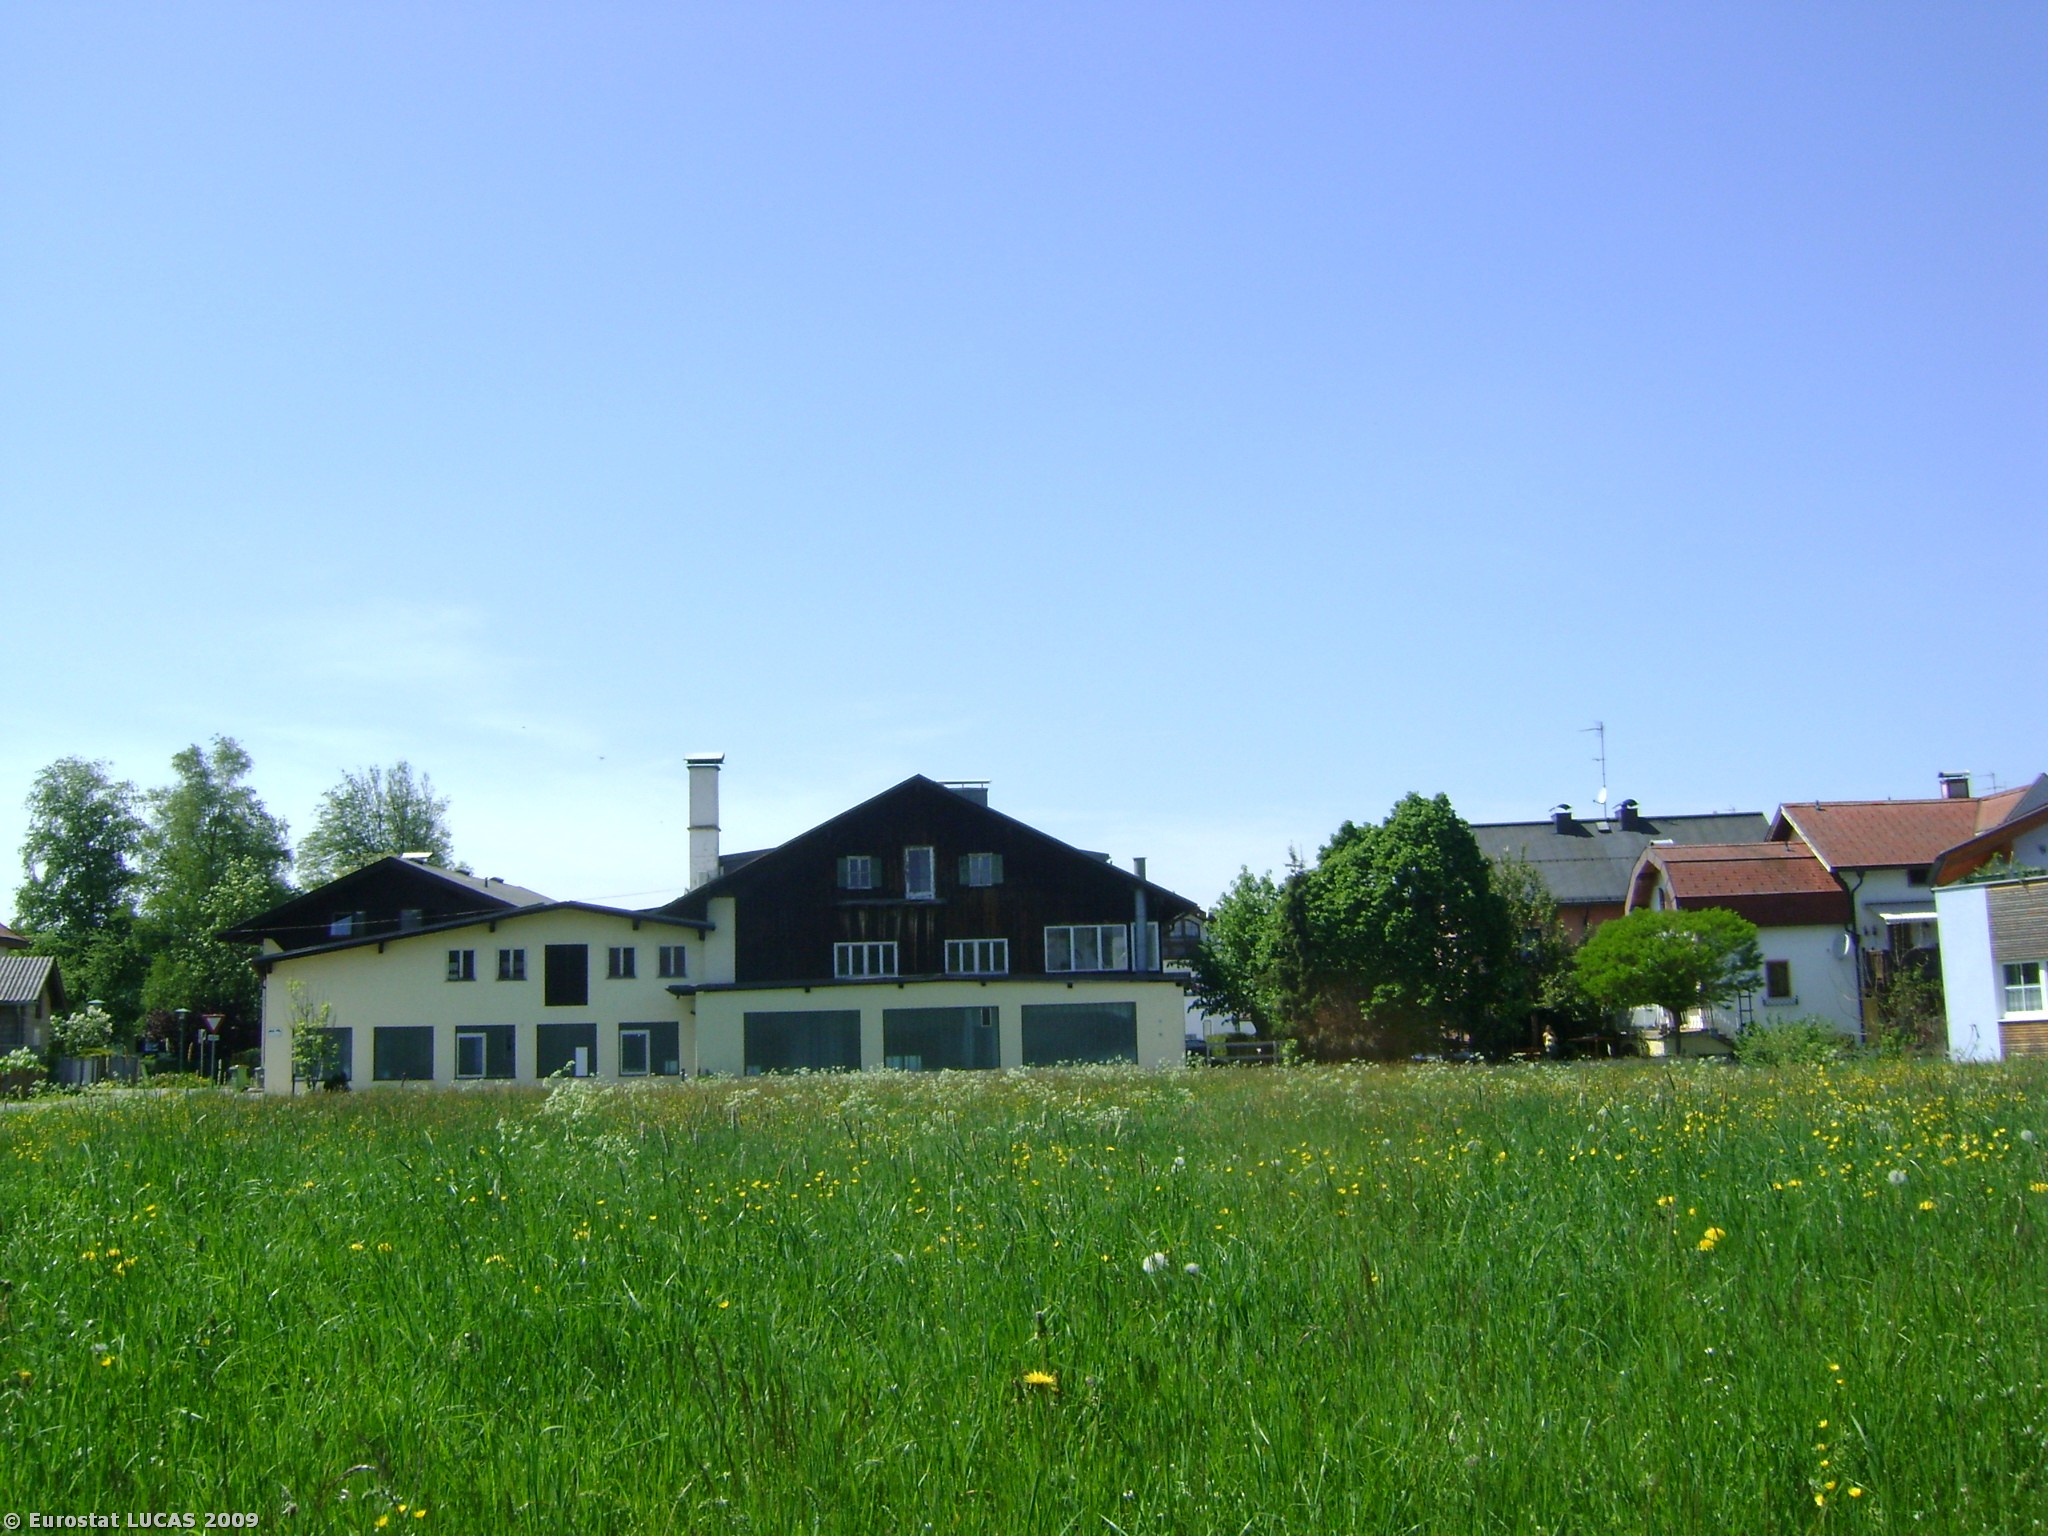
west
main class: Grassland
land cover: Grassland with sparse tree/shrub cover
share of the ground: > 75 %
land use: Agriculture (excluding fallow land and kitchen gardens)
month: May
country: AT
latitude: 47.9423
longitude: 13.2253
